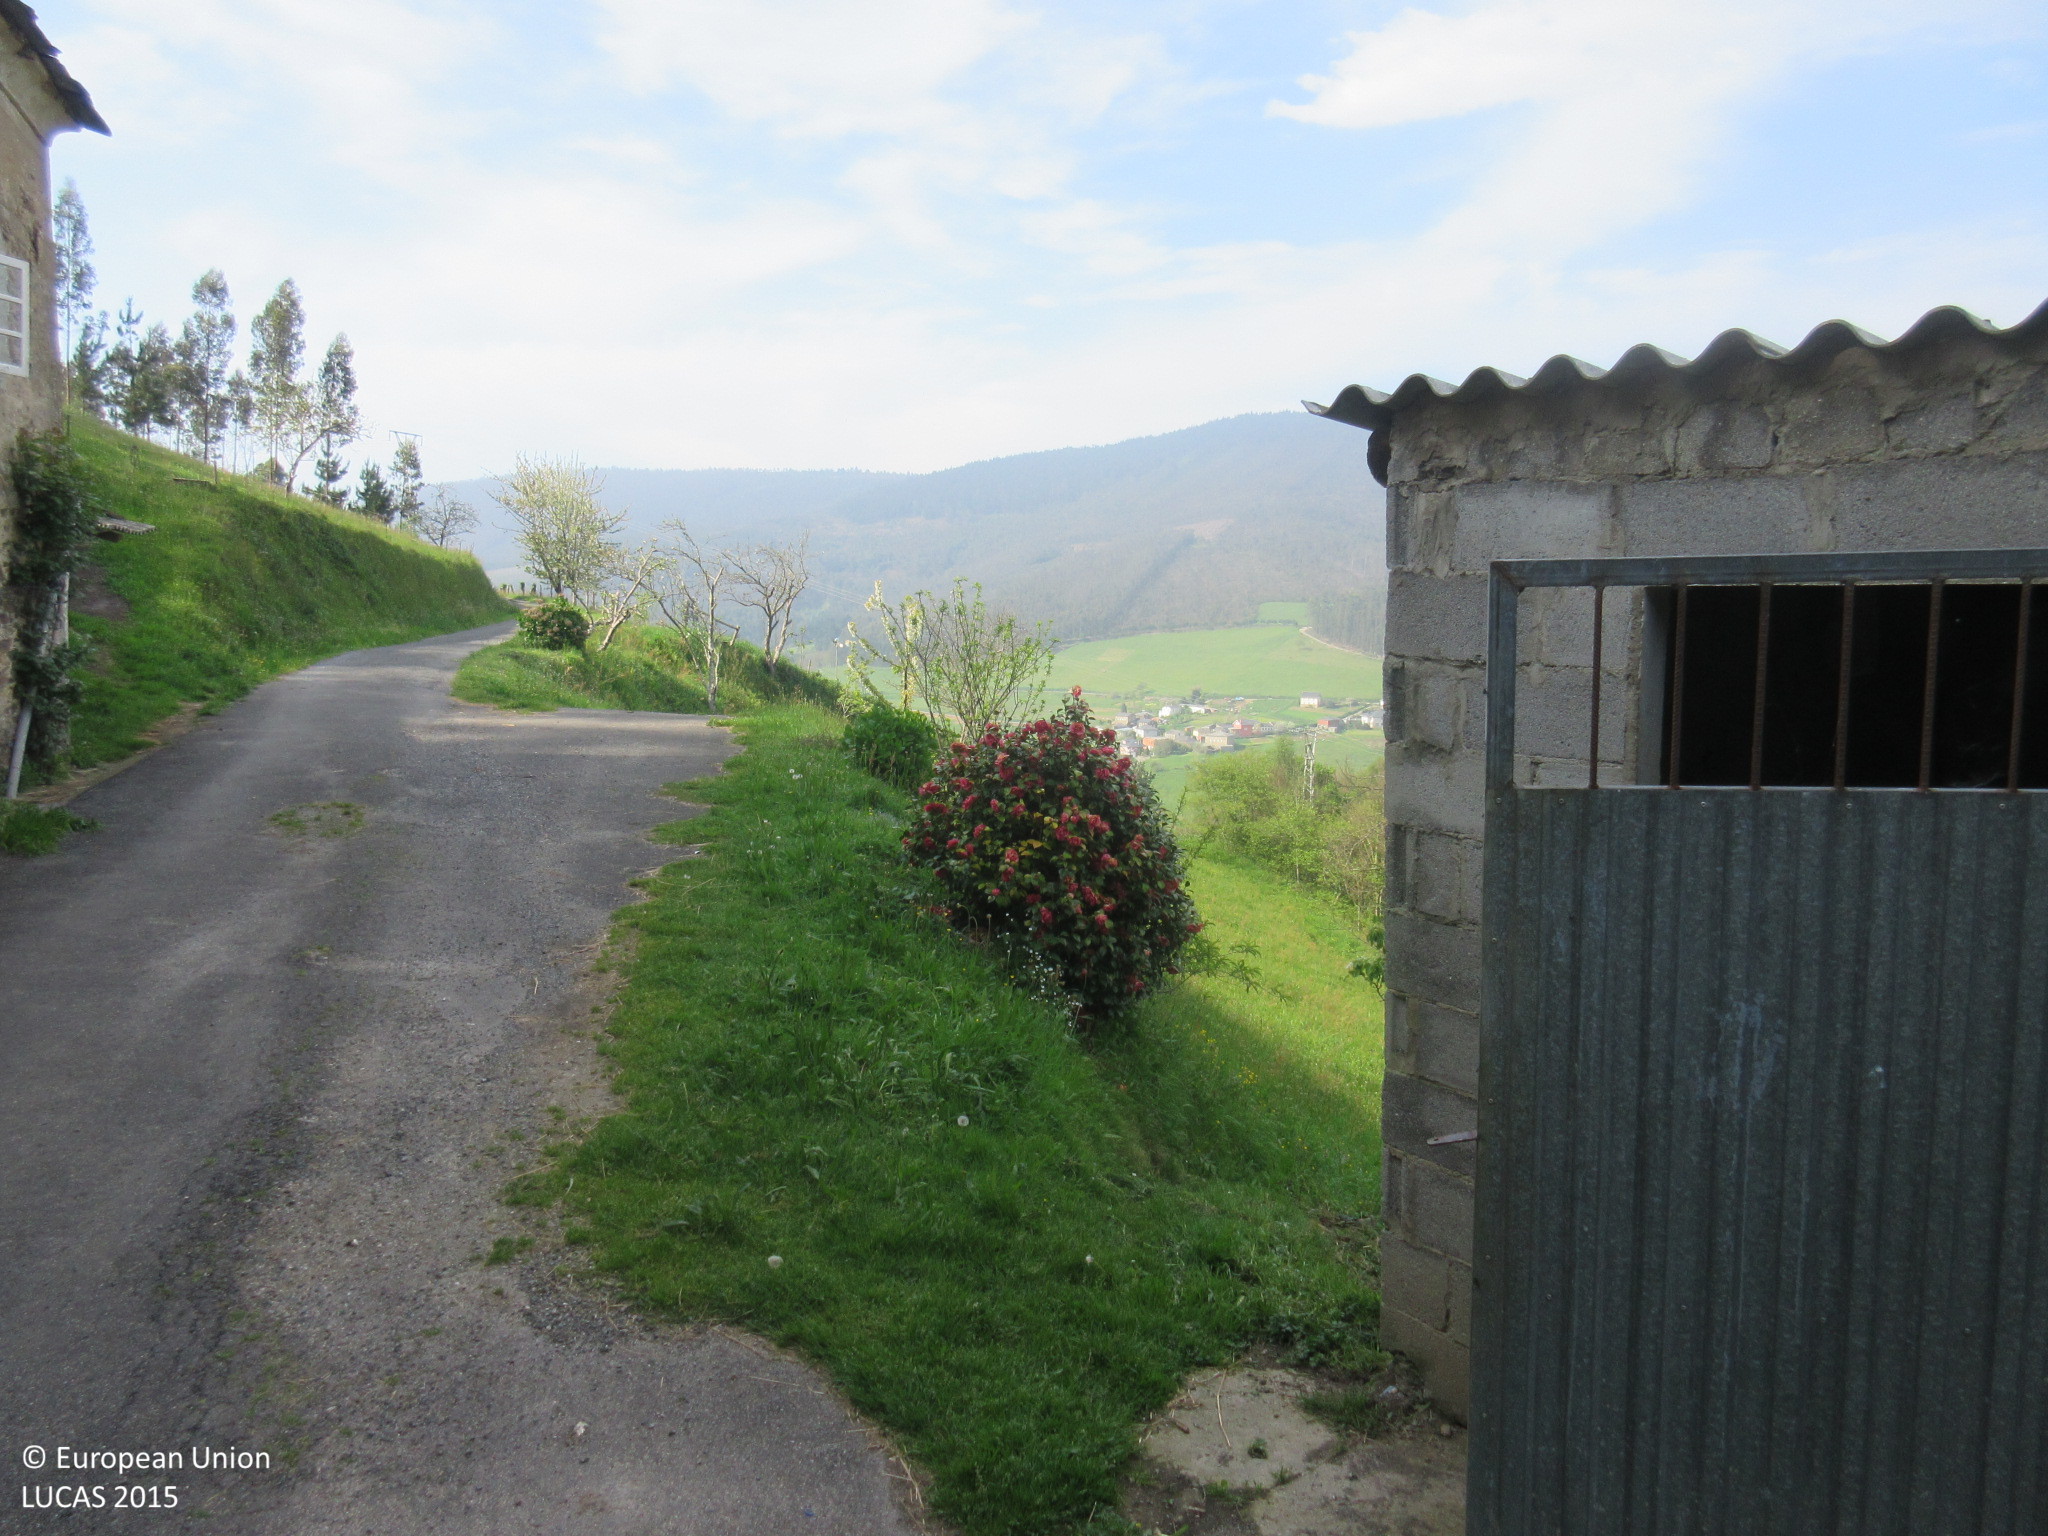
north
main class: Cropland
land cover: Potatoes
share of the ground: > 75 %
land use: Kitchen garden
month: April
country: ES
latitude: 43.4530
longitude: -6.9850
